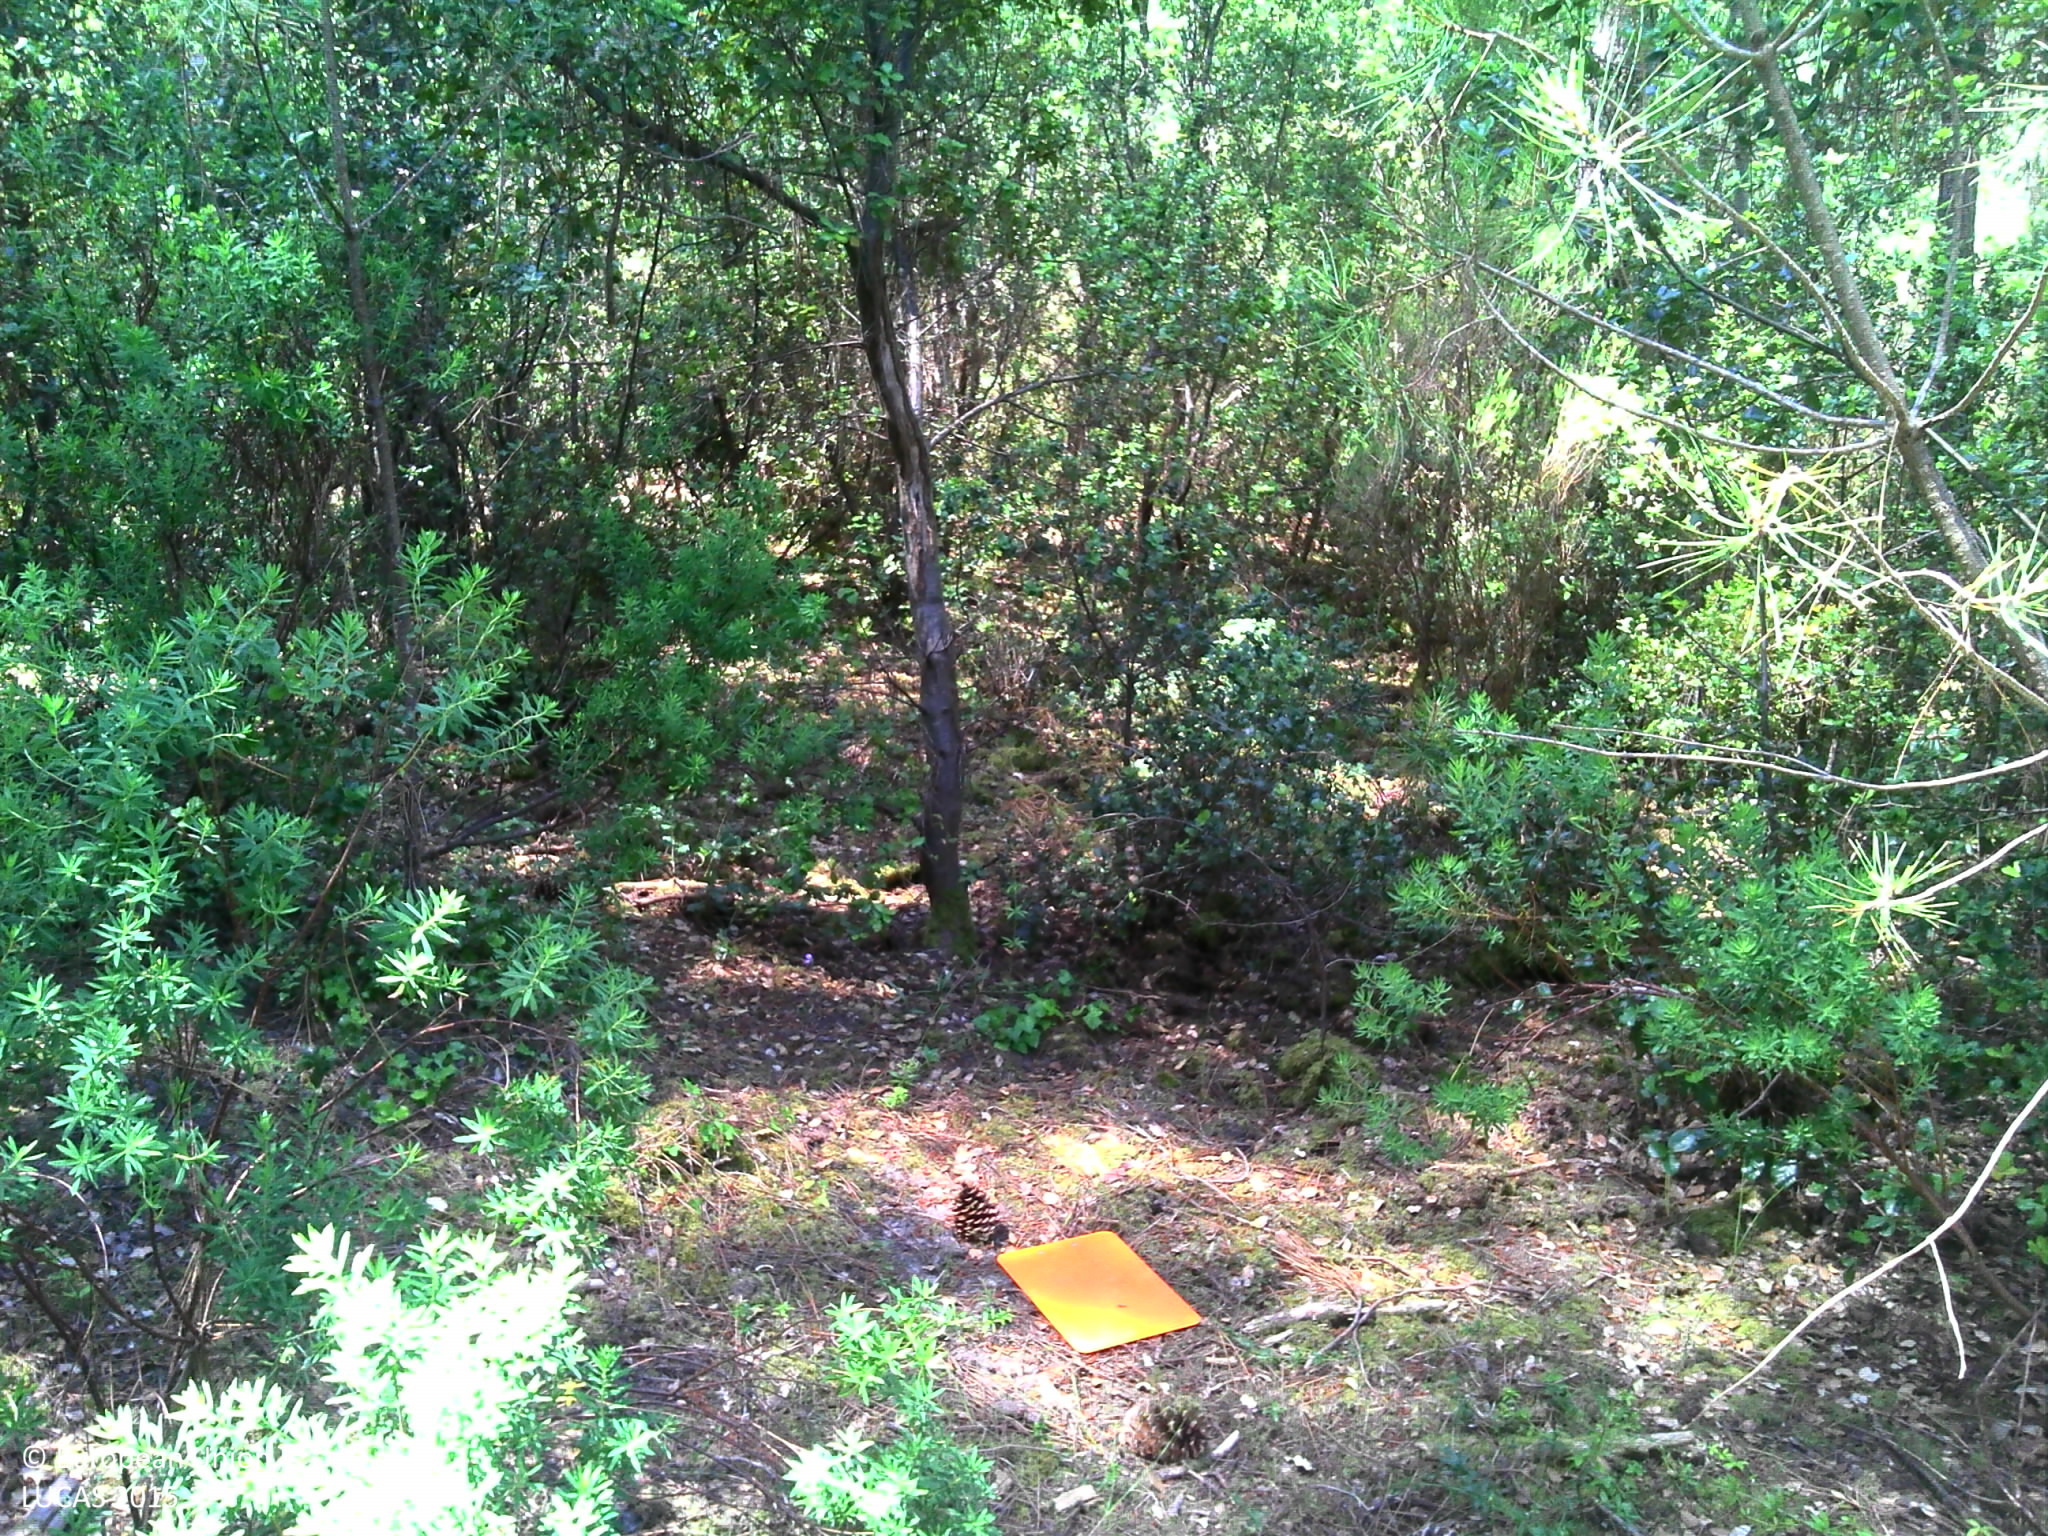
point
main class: Woodland
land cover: Pine dominated mixed woodland
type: coniferous forest of the mediterranean region
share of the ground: > 75 %
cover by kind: coniferous forest trees 75 %, broadleaved forest trees 25 %
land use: Forestry
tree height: > 5 m
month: June
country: FR
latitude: 45.7073
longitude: -1.1921
